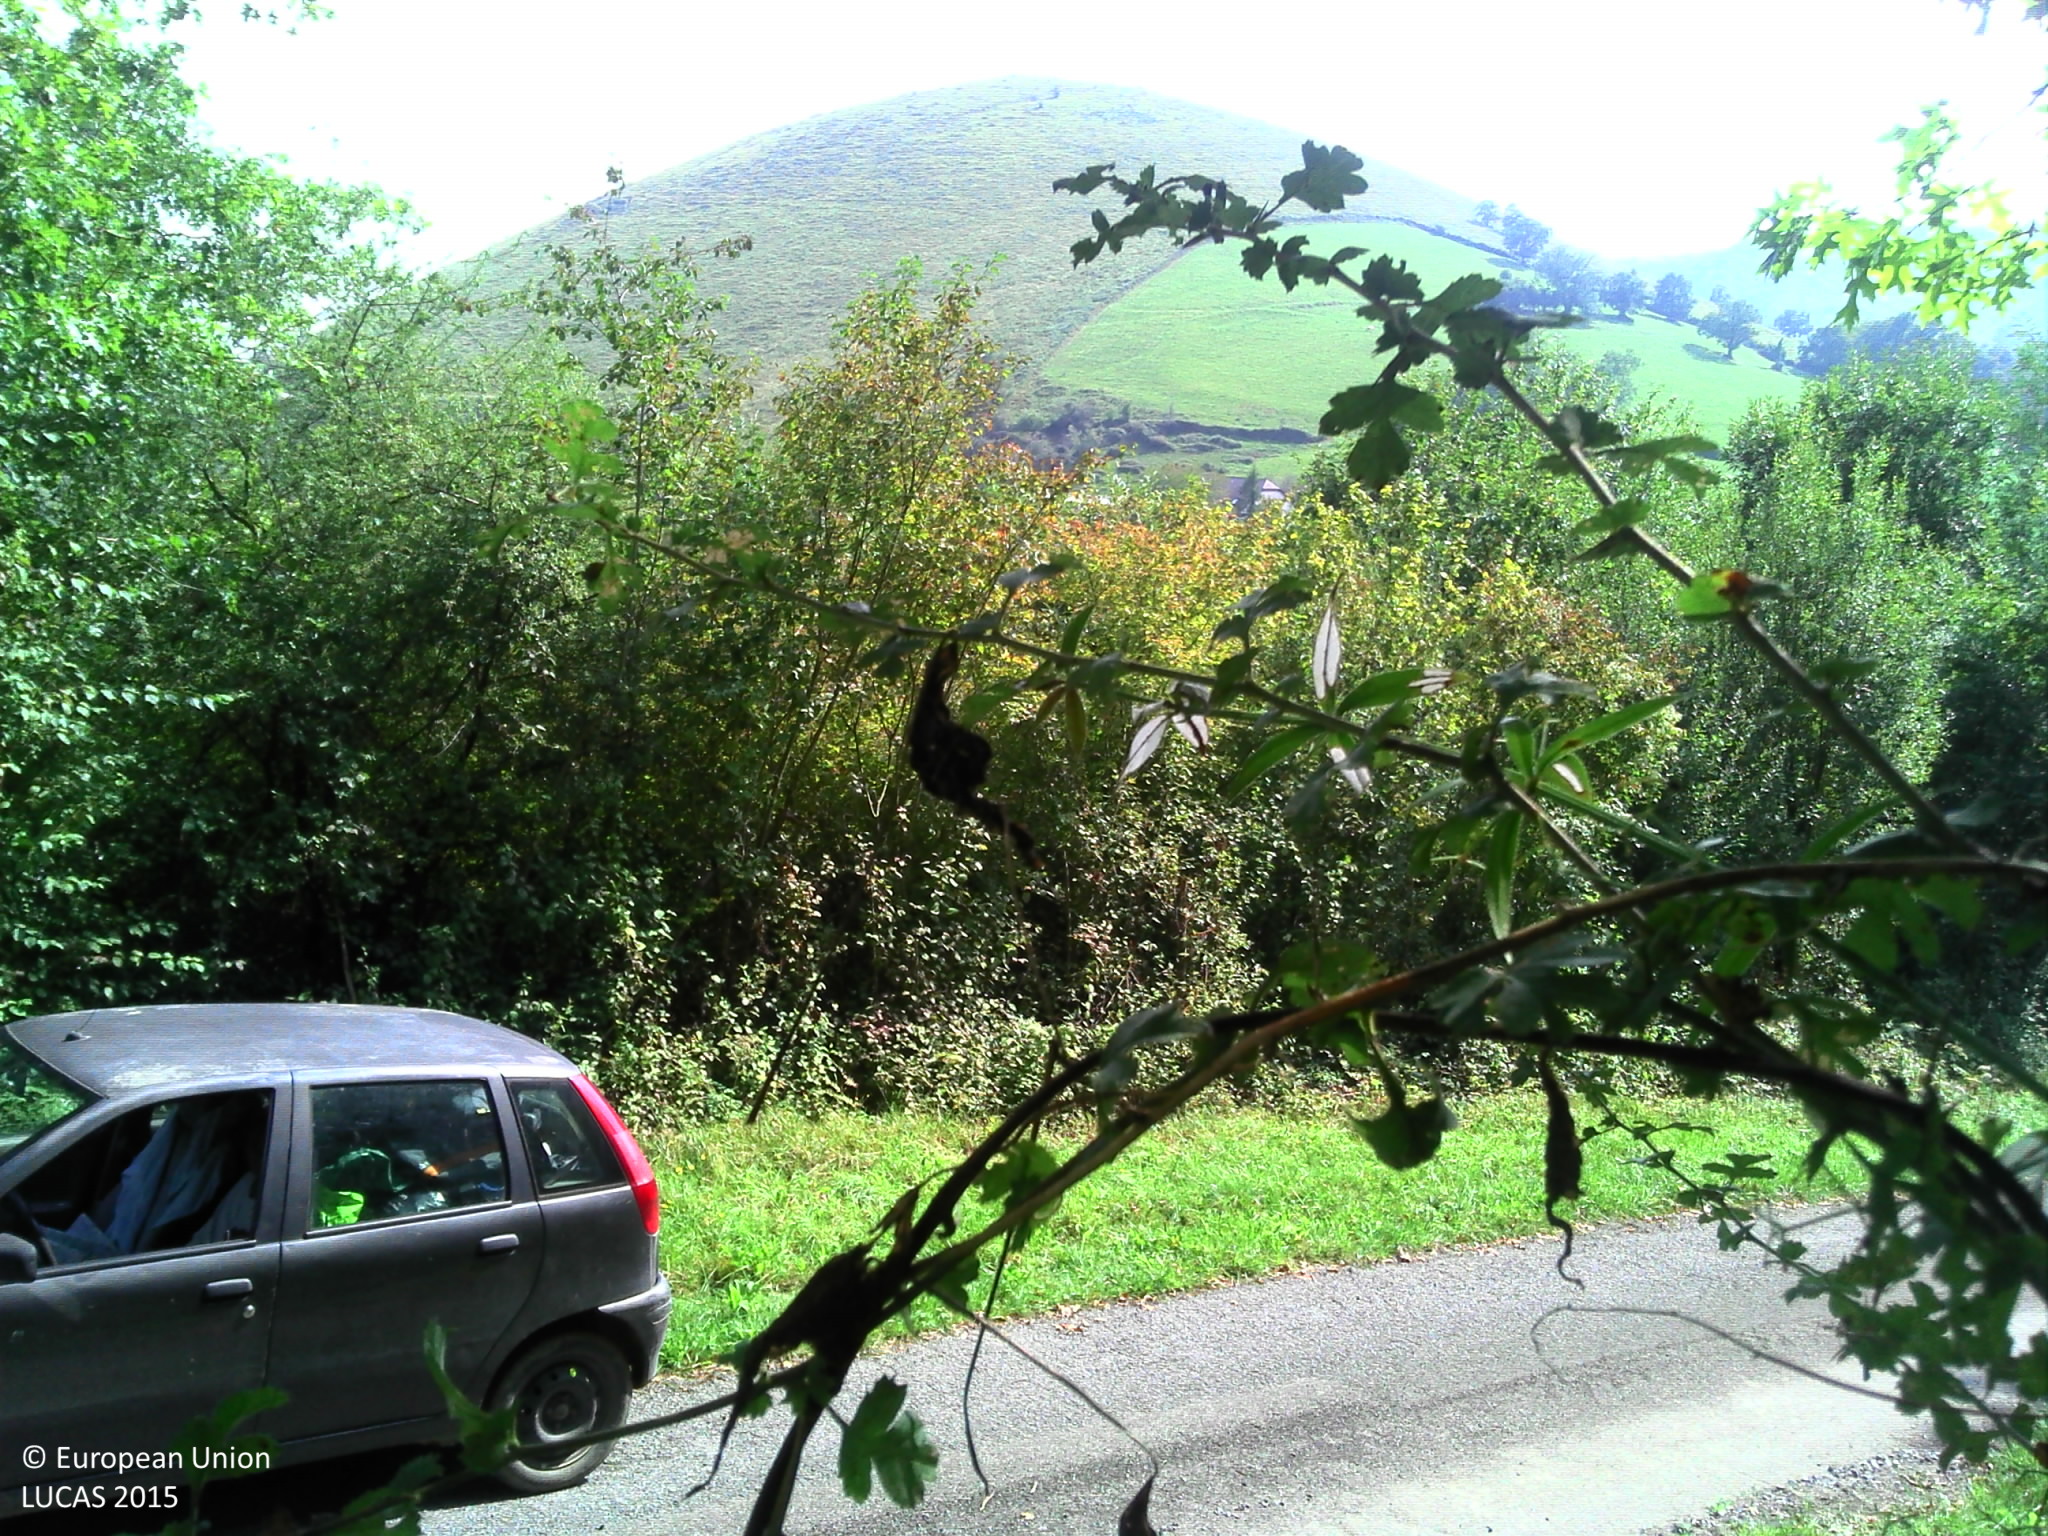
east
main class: Woodland
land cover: Broadleaved woodland
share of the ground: > 75 %
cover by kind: broadleaved forest trees 60 %, shrubs 30 %, herbaceous plants 5 %, lichens and mosses 5 %
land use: Forestry
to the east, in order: Broadleaved woodland; Fences; Ditches and canals; Grass margins; Paved roads, cycling and walking lanes; Grass margins; Broadleaved woodland; Tracks; Abandoned hedges; Fences; Grassland without tree/shrub cover; Artificial constructions in urban areas; Grassland without tree/shrub cover; Fences; Spontaneously vegetated surfaces; Artificial constructions in urban areas
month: September
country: FR
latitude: 43.1972
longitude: -1.0256
